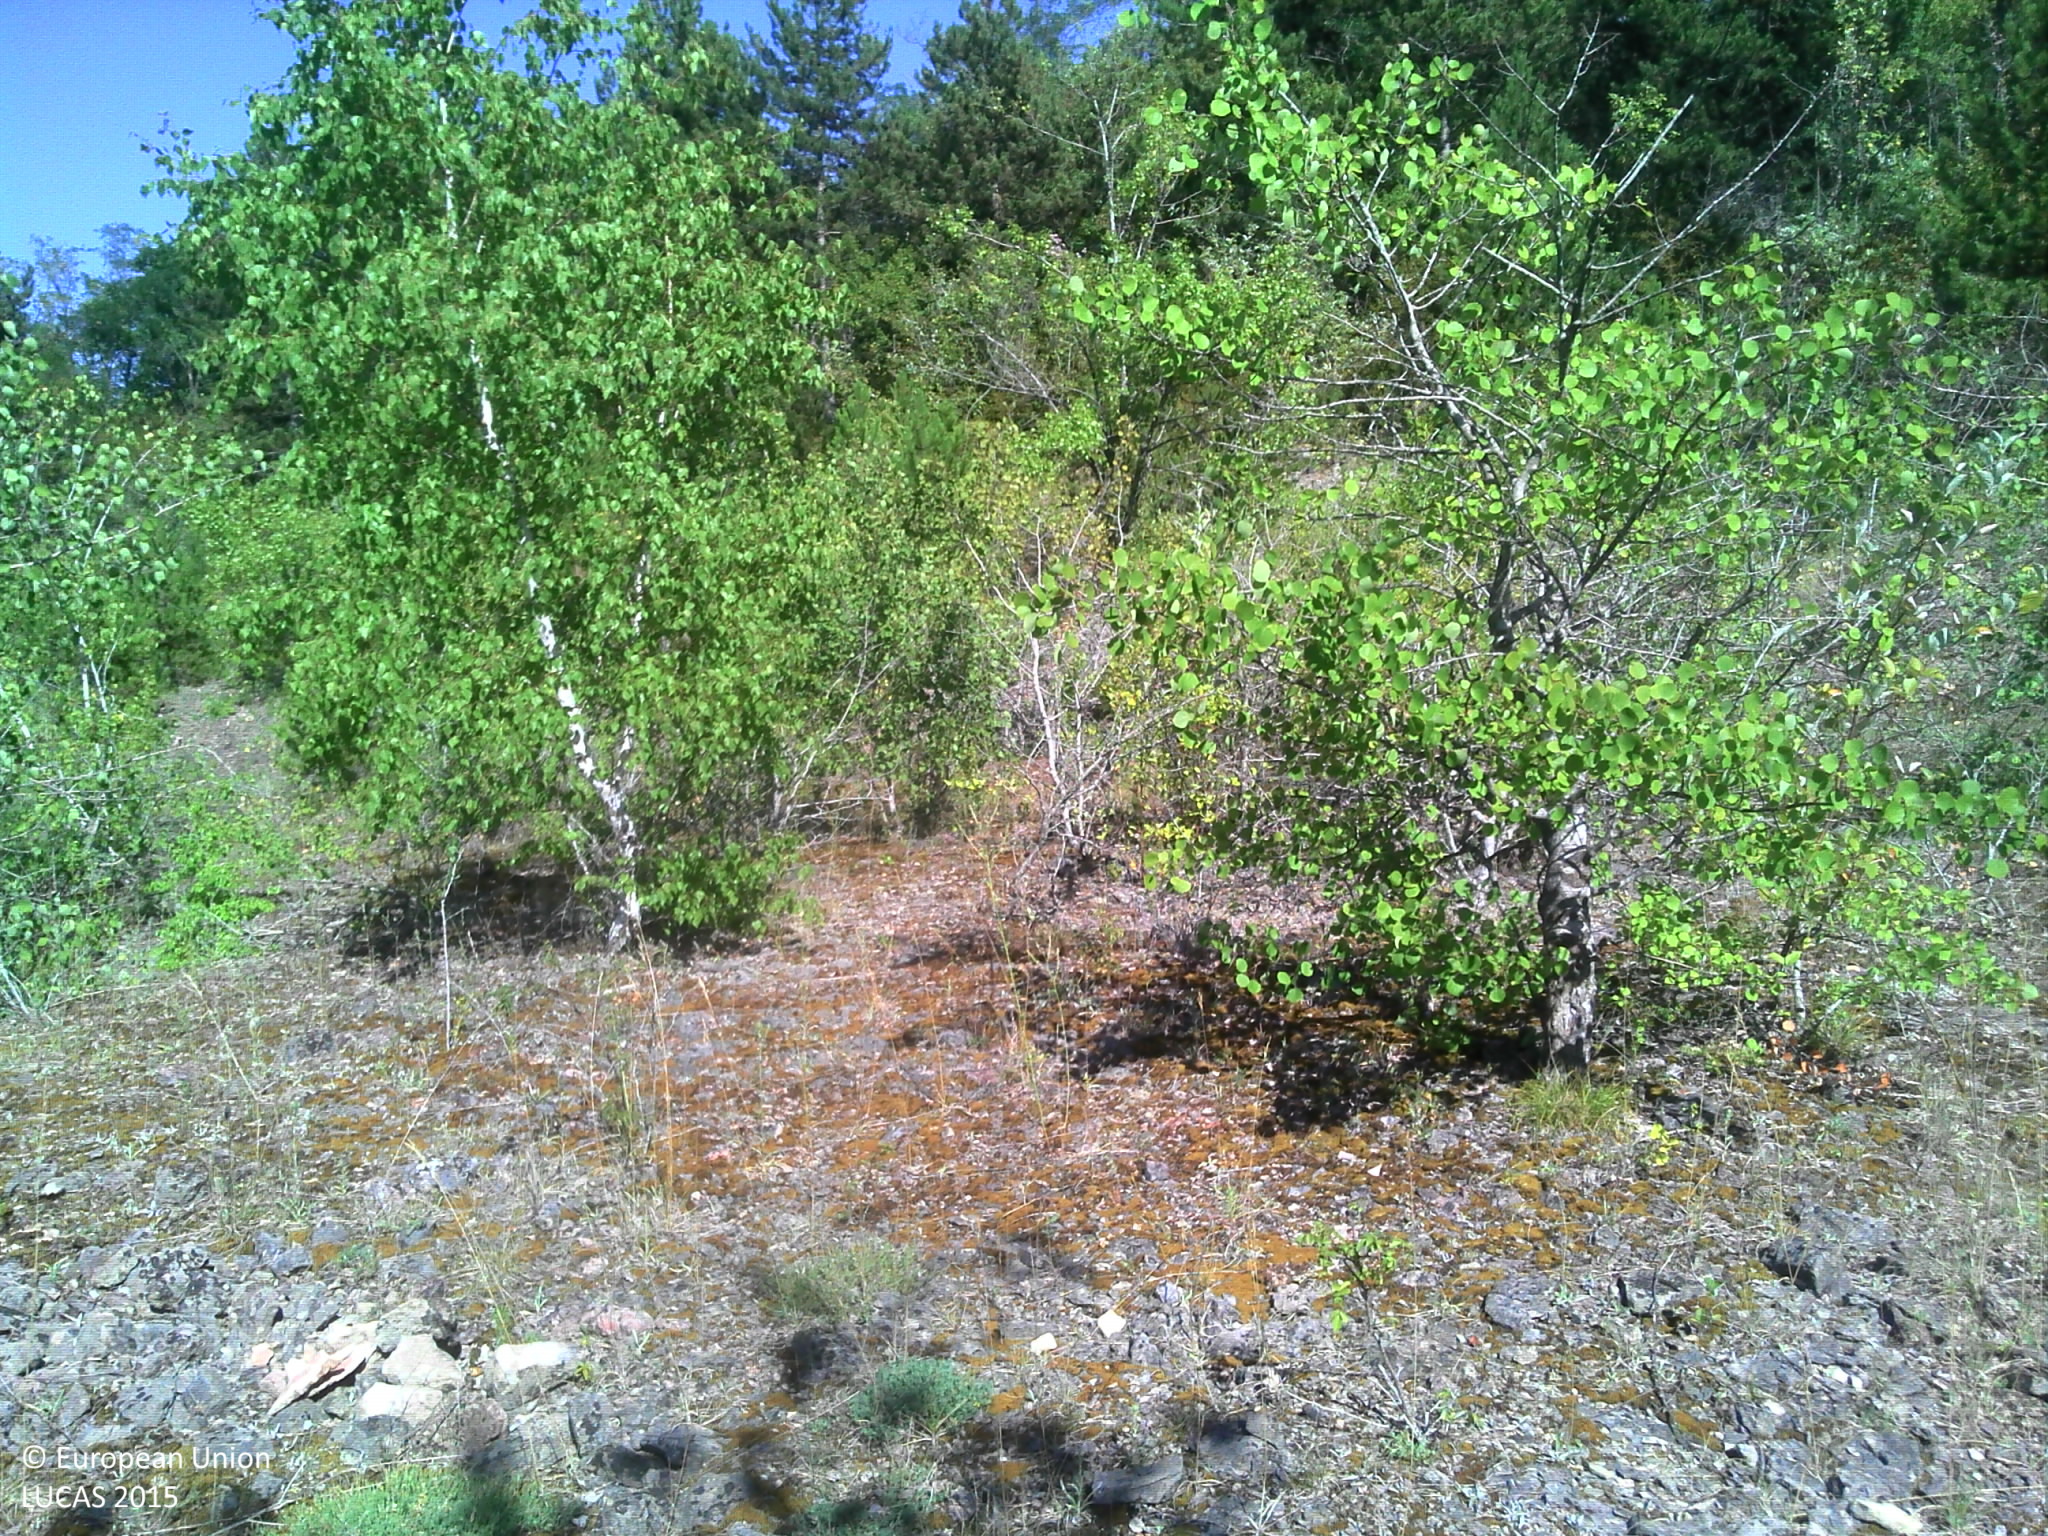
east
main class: Shrubland
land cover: Shrubland with sparse tree cover
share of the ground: > 75 %
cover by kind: shrubs 45 %, unconsolidated bare surface 30 %, herbaceous plants 20 %, broadleaved forest trees 5 %
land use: Semi-natural and natural areas not in use
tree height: < 5 m
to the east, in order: Shrubland with sparse tree cover; Rocks and stones; Shrubland with sparse tree cover; Pine dominated mixed woodland; Shrubland with sparse tree cover; Pine dominated mixed woodland; Shrubland with sparse tree cover; Tracks; Rocks and stones; Shrubland with sparse tree cover; Tracks; Shrubland with sparse tree cover
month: July
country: FR
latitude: 46.8535
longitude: 4.7417
